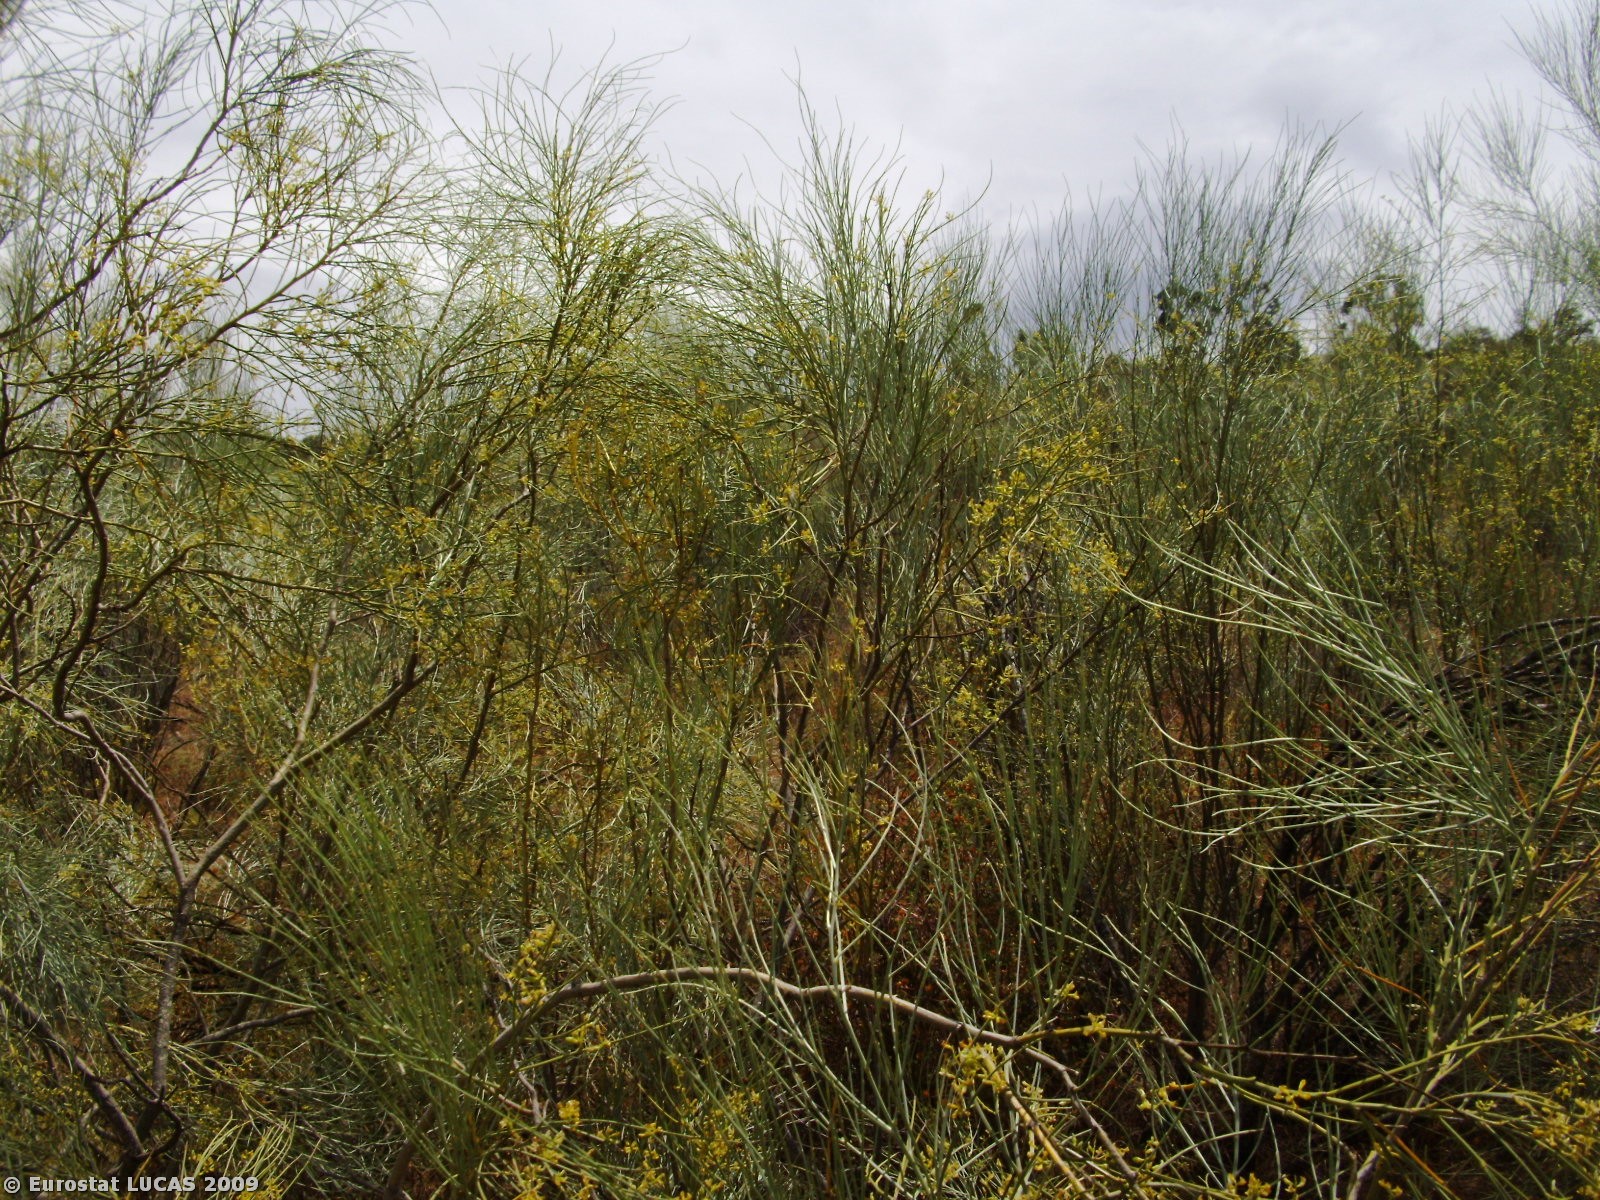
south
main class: Shrubland
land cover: Shrubland without tree cover
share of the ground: > 75 %
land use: Unused
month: June
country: PT
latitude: 39.7250
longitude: -7.1337
